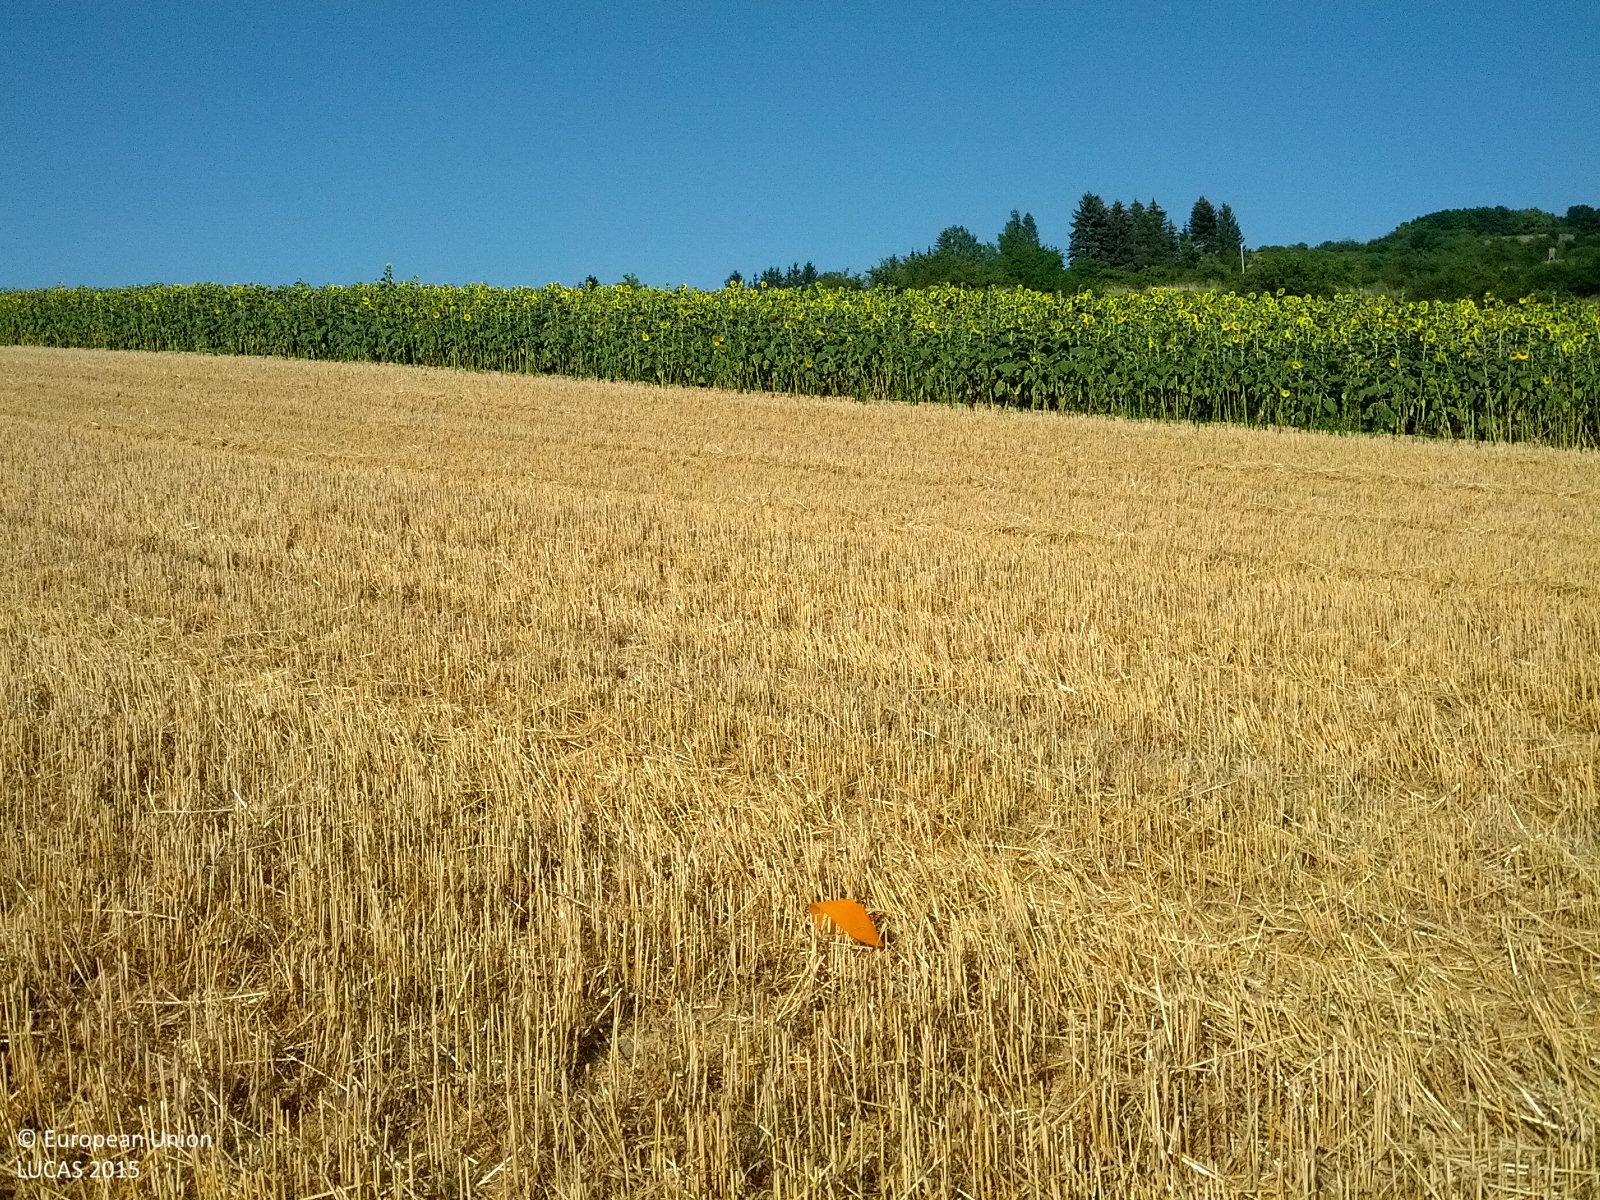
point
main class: Cropland
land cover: Common wheat
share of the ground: 10 - 25 %
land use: Agriculture (excluding fallow land and kitchen gardens)
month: July
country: AT
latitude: 48.4245
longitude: 16.2618
